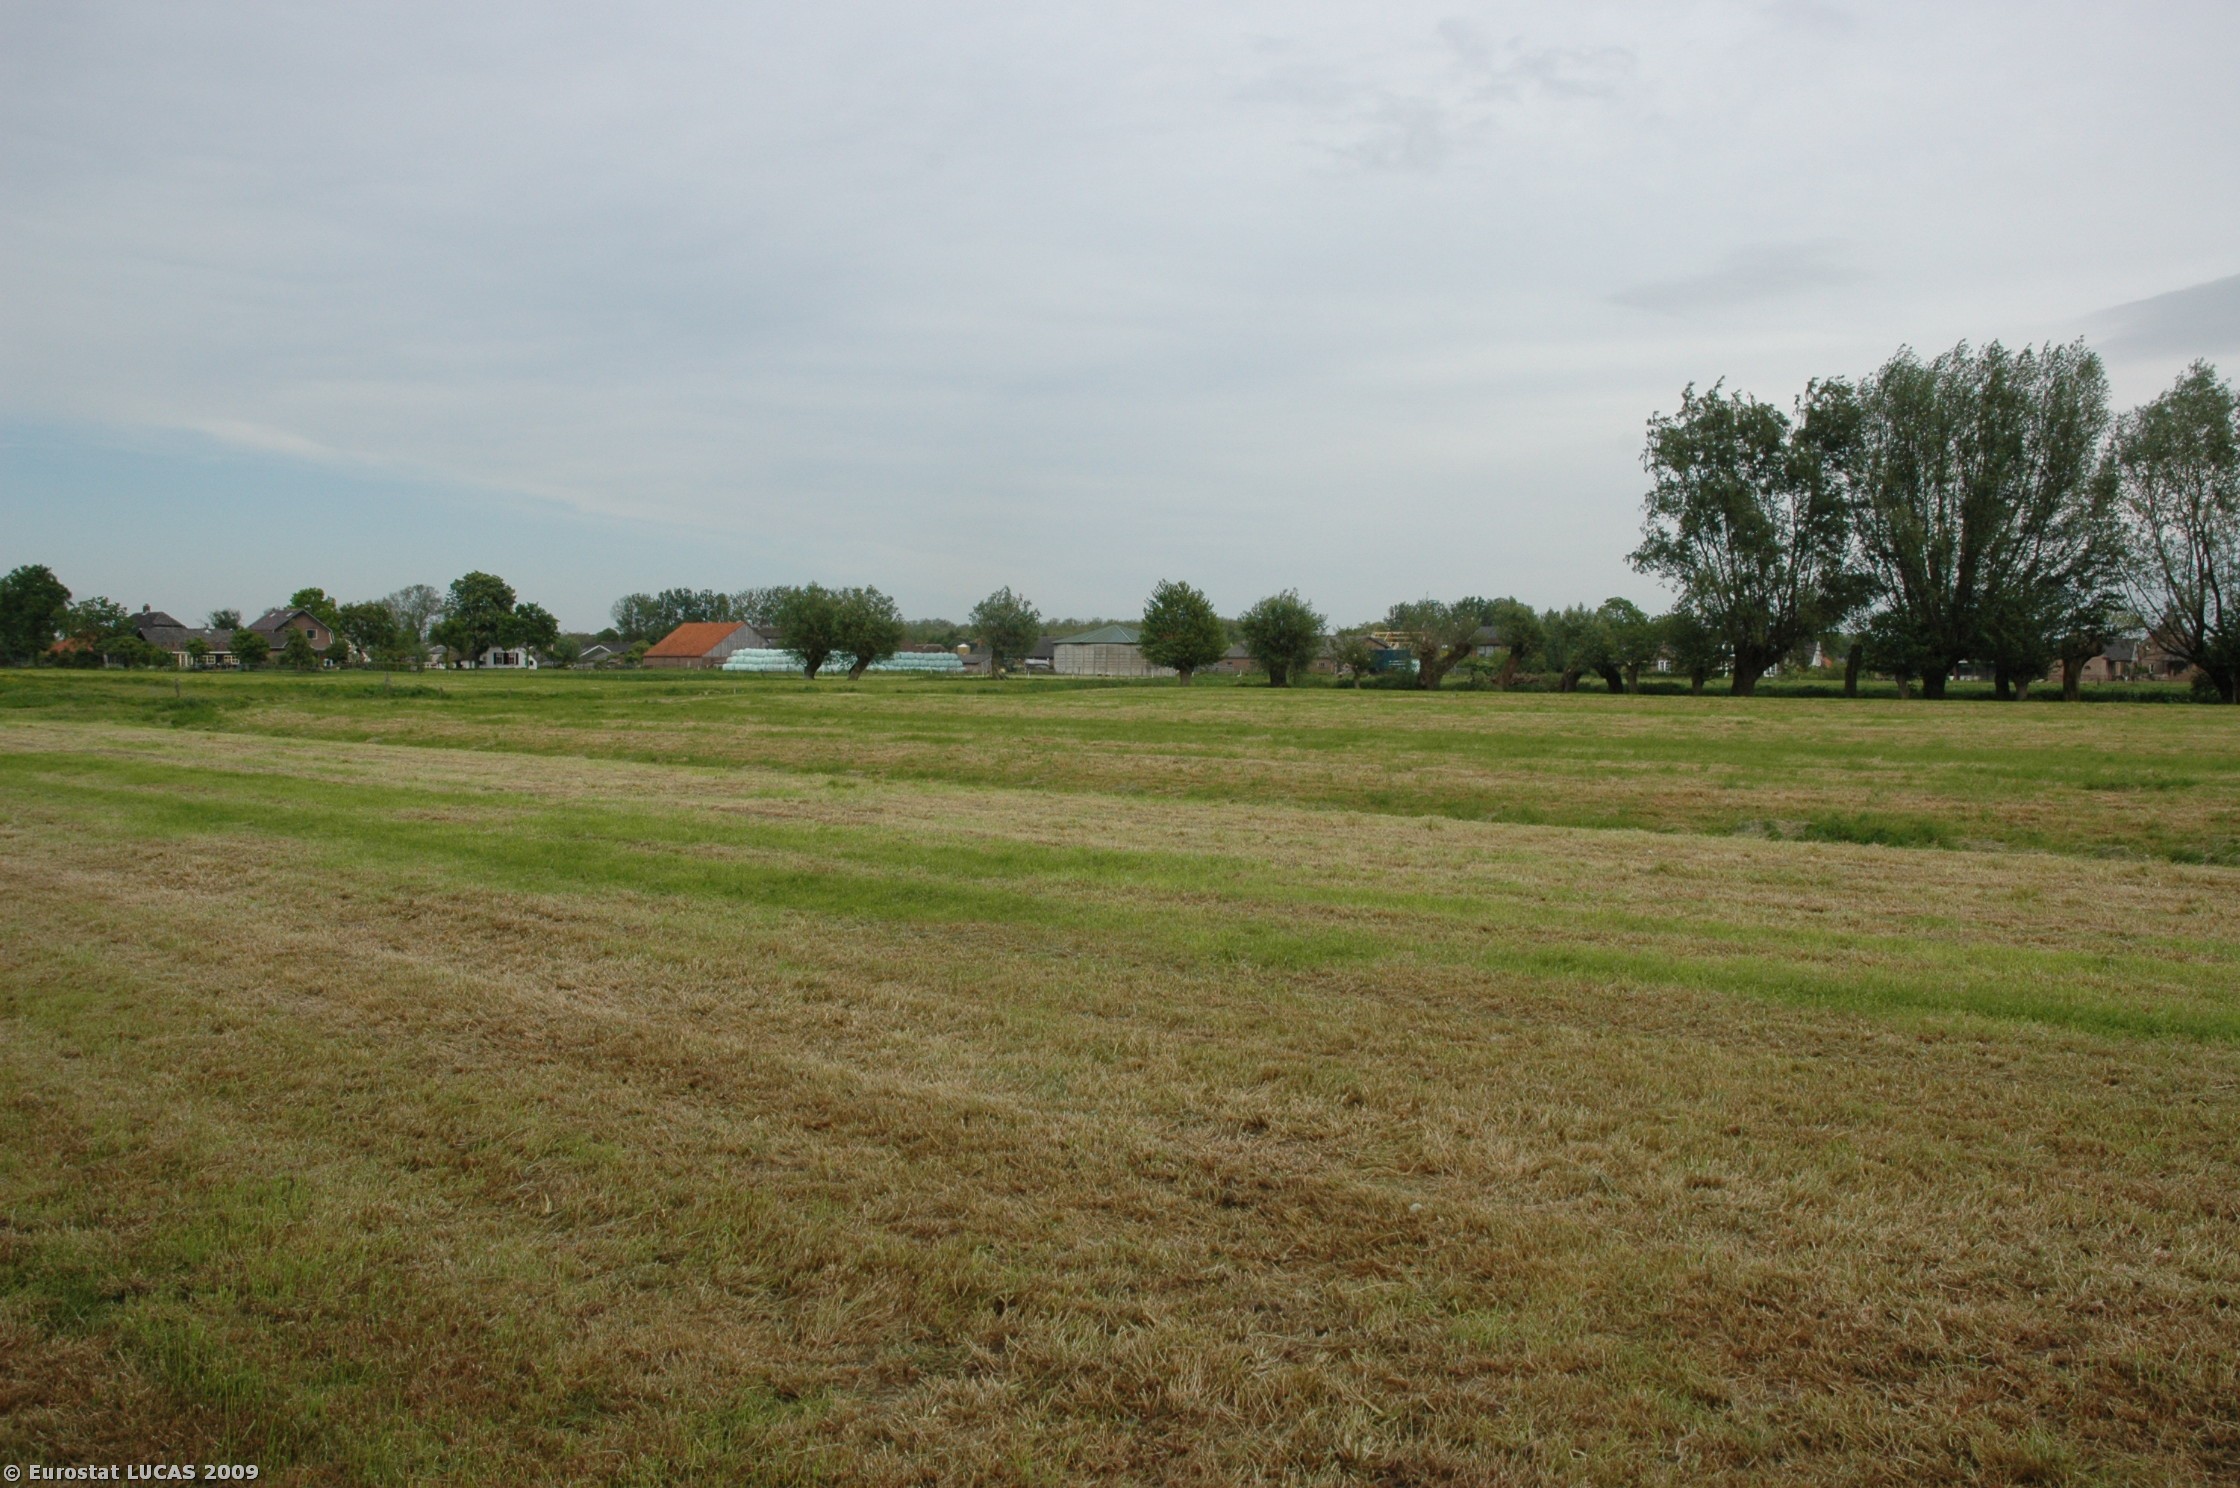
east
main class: Grassland
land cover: Grassland without tree/shrub cover
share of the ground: > 75 %
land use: Unused
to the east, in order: Grassland without tree/shrub cover; Broadleaved woodland; Ditches and canals; Fences; Grassland without tree/shrub cover; Fences; Ditches and canals; Fences; Lines of trees; Grassland without tree/shrub cover; Fences; Grassland without tree/shrub cover; Fences; Grassland without tree/shrub cover; Artificial constructions in urban areas
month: May
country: NL
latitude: 51.9984
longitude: 5.3517
